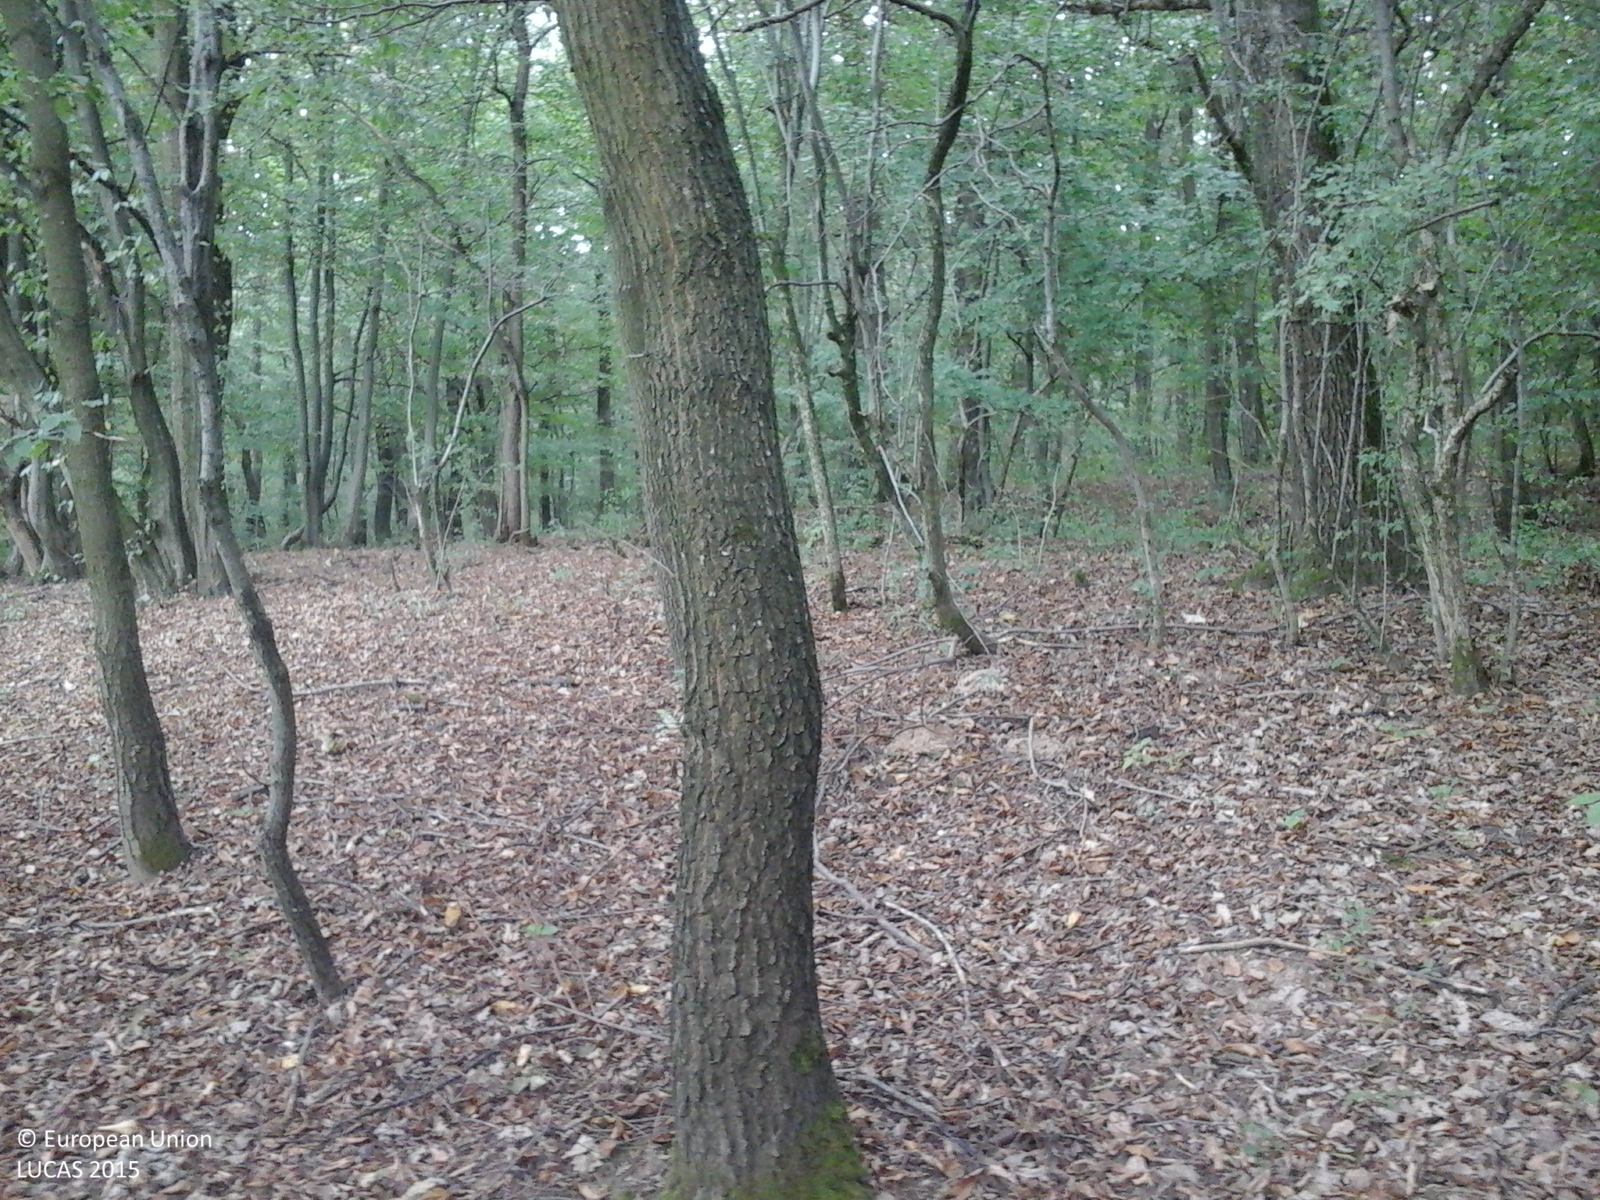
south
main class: Woodland
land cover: Broadleaved woodland
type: acidophilous oak and oak-birch forest
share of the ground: > 75 %
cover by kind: broadleaved forest trees 100 %
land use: Forestry
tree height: > 5 m
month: September
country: RO
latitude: 47.2400
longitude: 23.0770
